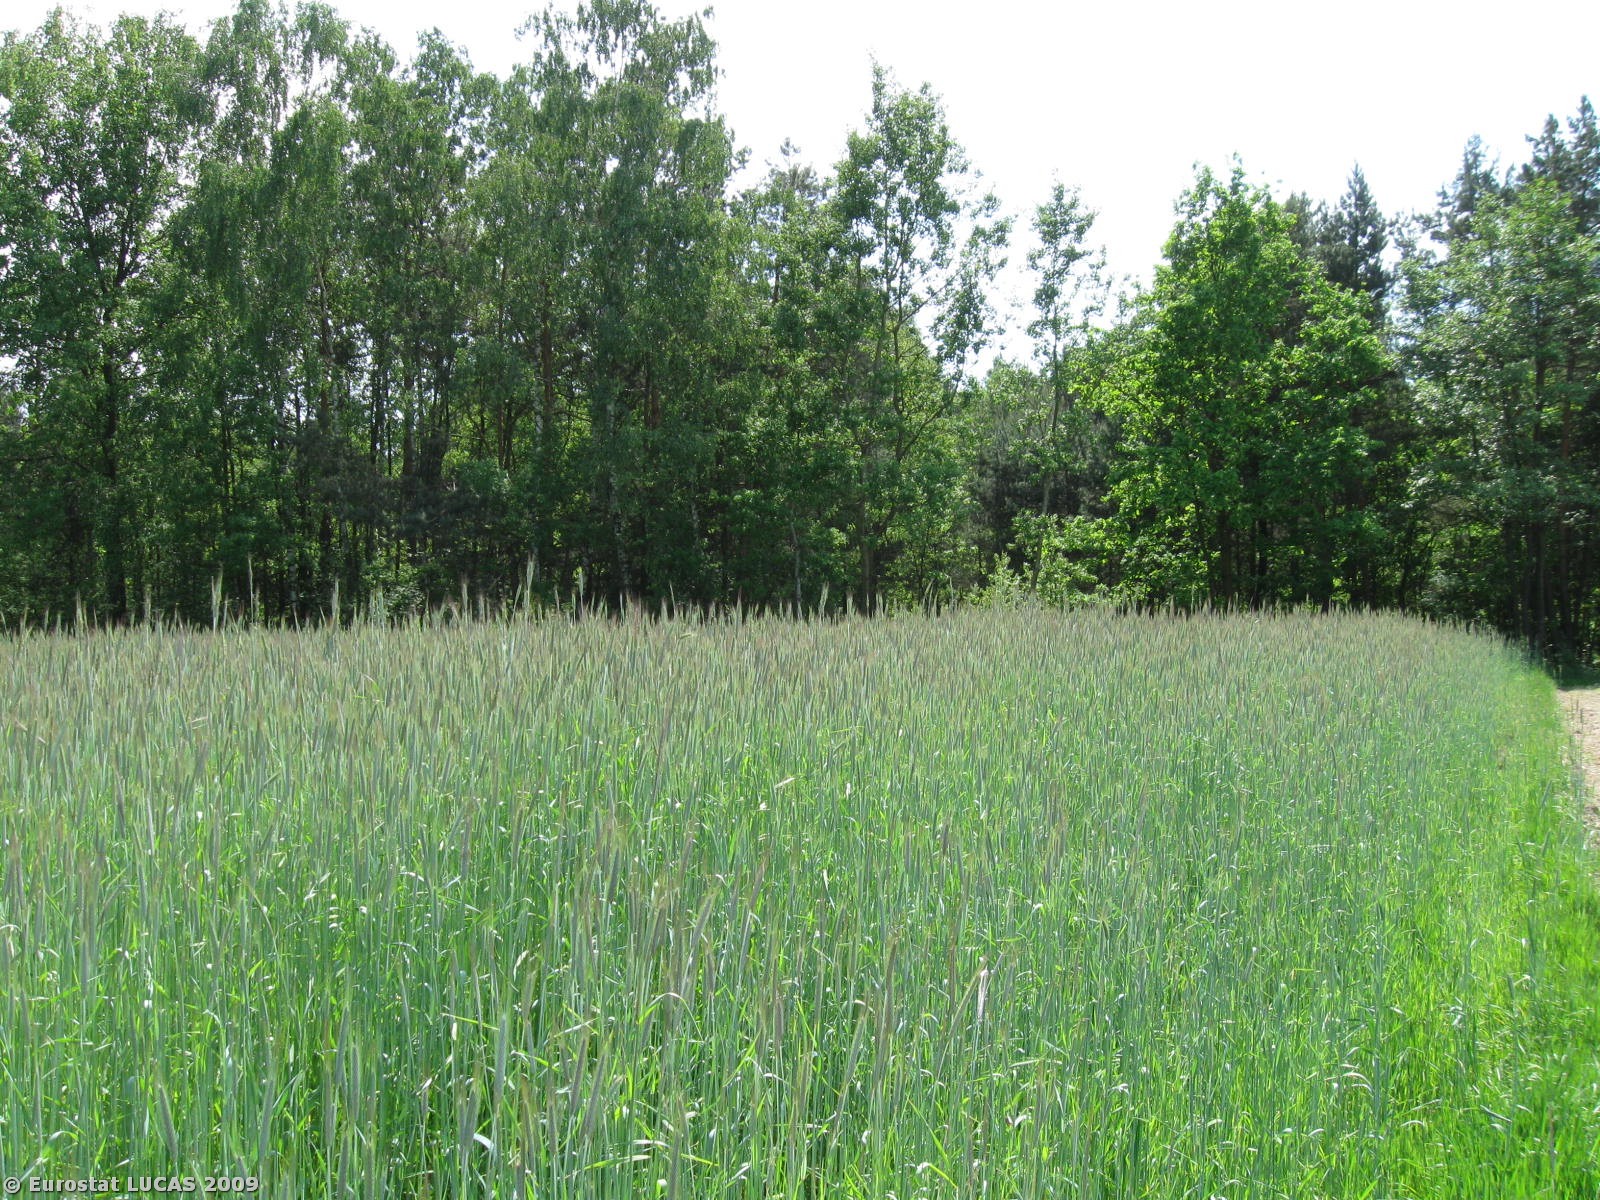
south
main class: Cropland
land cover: Rye
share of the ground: > 75 %
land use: Agriculture (excluding fallow land and kitchen gardens)
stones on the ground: < 10 %
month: May
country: PL
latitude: 50.6498
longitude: 20.4040
